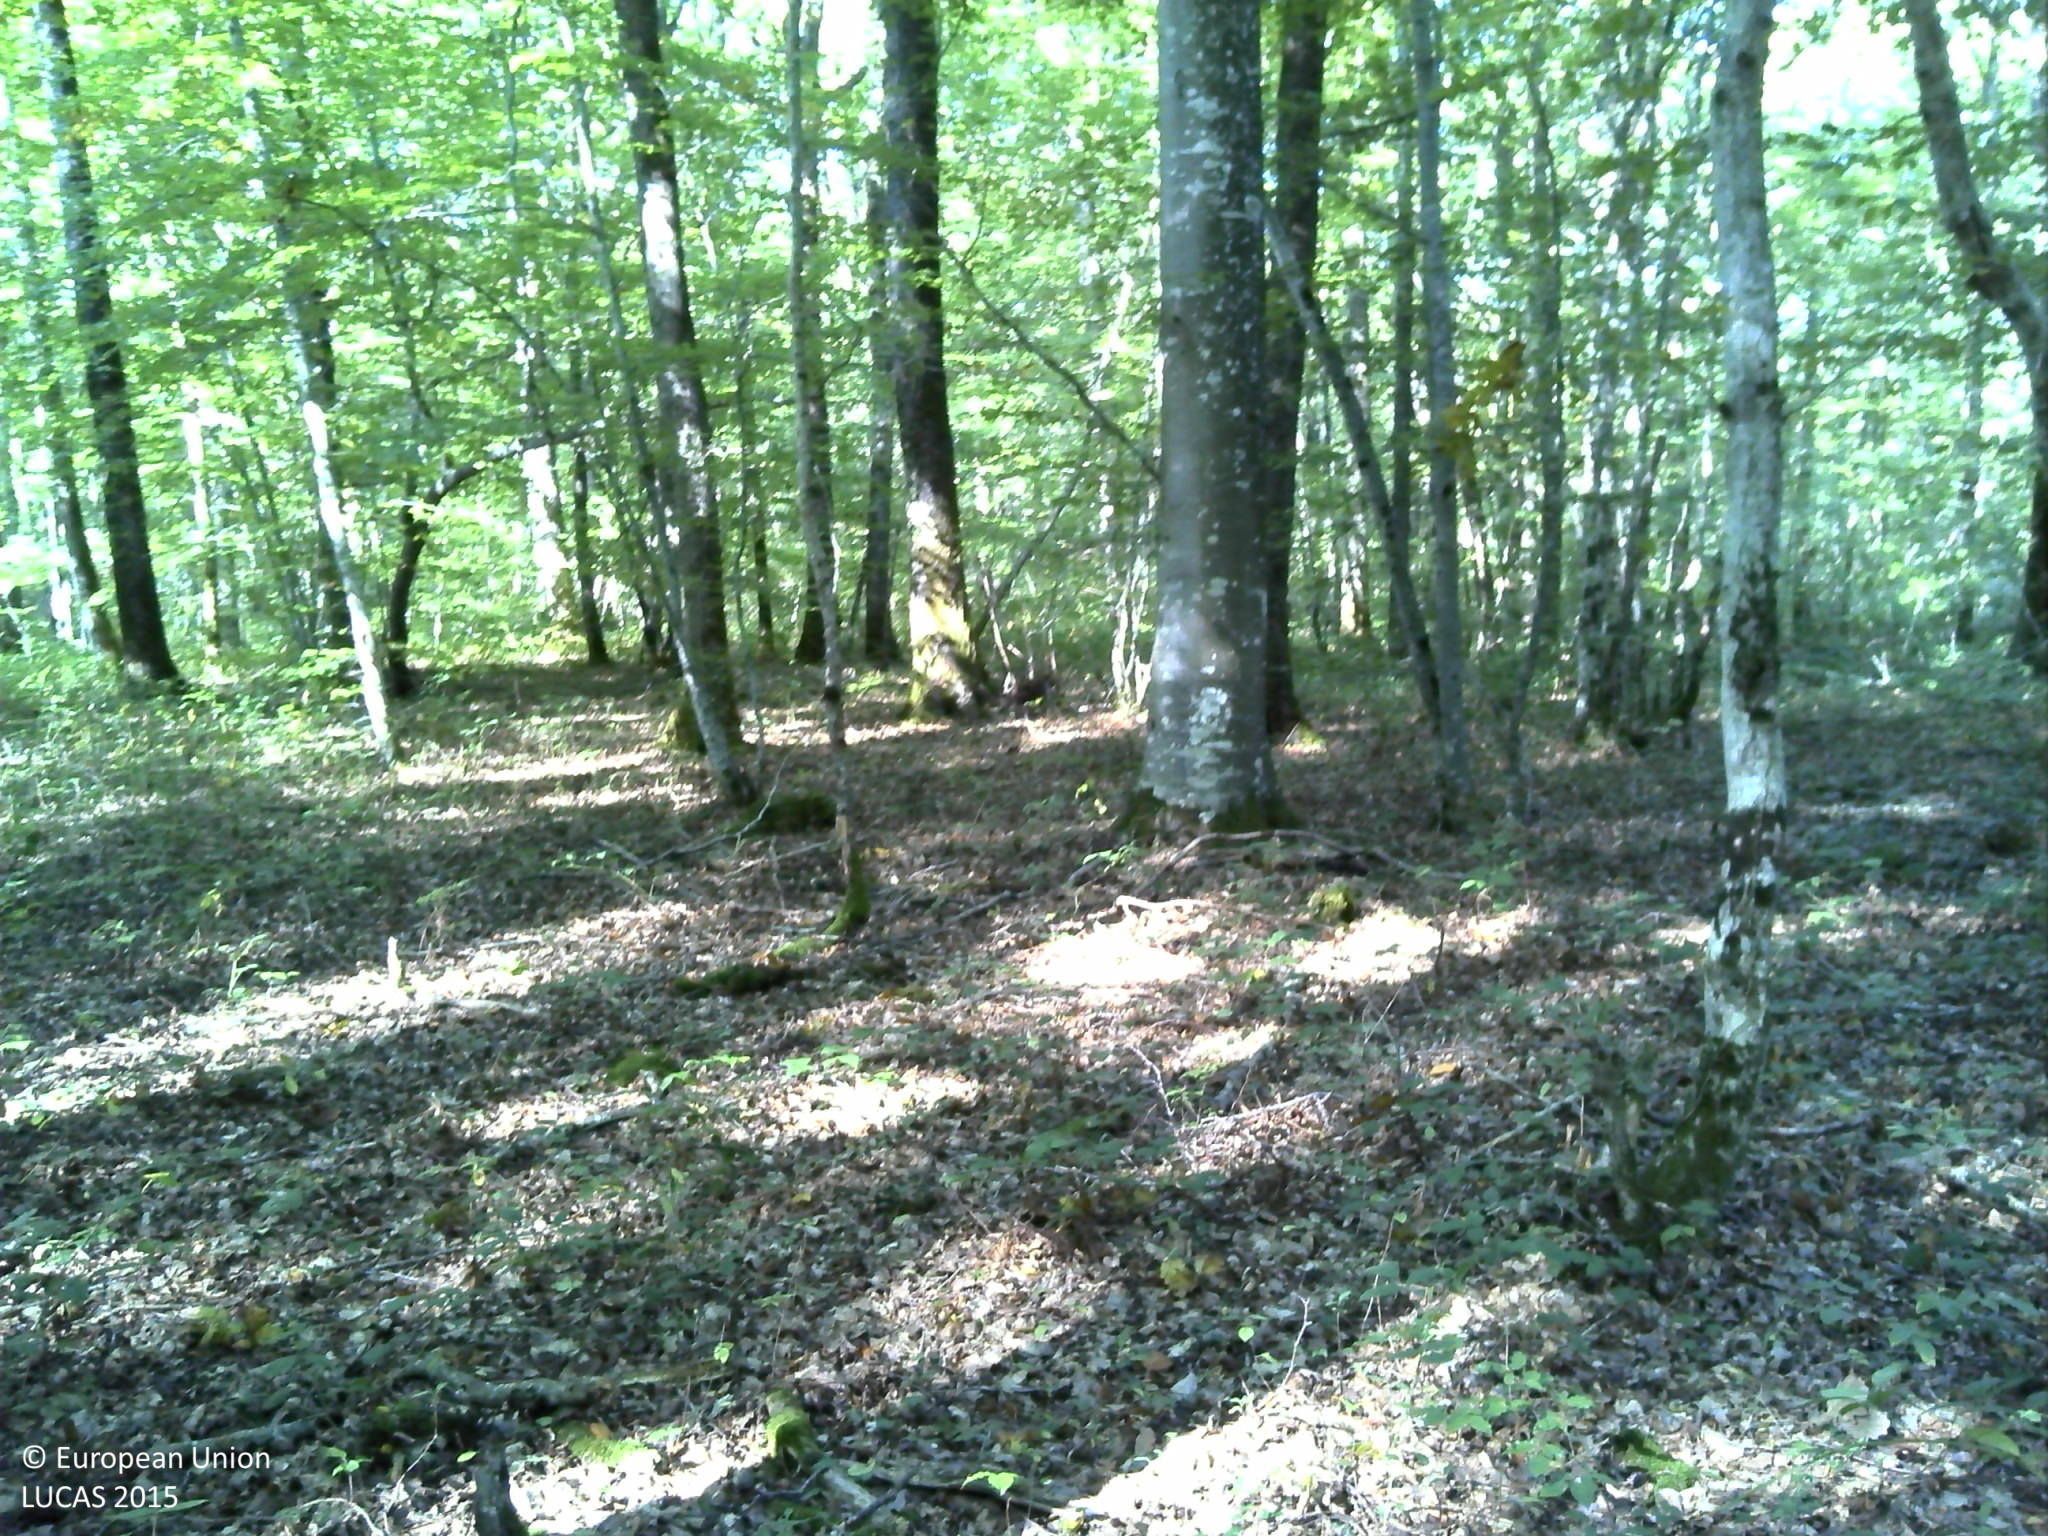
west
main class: Woodland
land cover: Broadleaved woodland
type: mesophytic deciduous forest
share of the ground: > 75 %
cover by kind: broadleaved forest trees 85 %, herbaceous plants 10 %, lichens and mosses 5 %
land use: Forestry
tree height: > 5 m
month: September
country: FR
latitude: 46.8736
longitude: 4.4242
